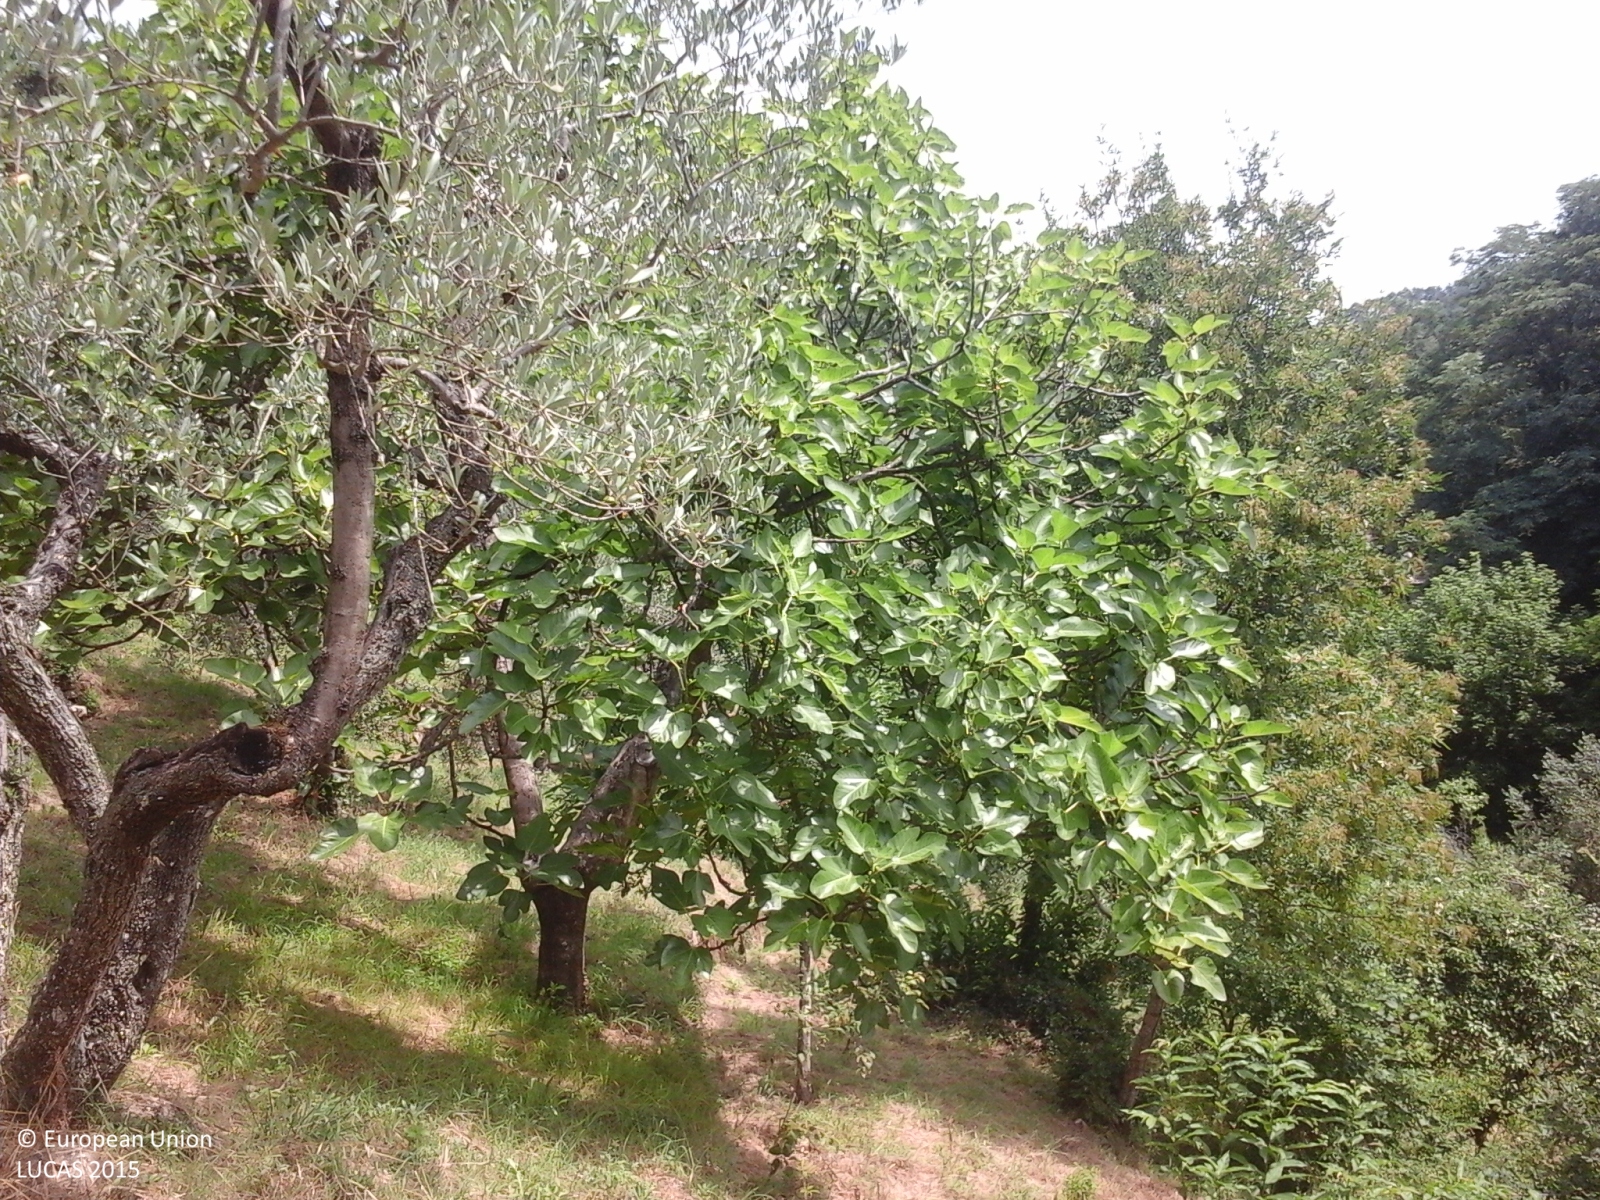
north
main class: Cropland
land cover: Olive groves
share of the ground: 10 - 25 %
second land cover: Grassland without tree/shrub cover
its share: 25 - 50 %
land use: Agriculture (excluding fallow land and kitchen gardens)
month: June
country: IT
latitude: 43.8052
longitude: 10.9298
